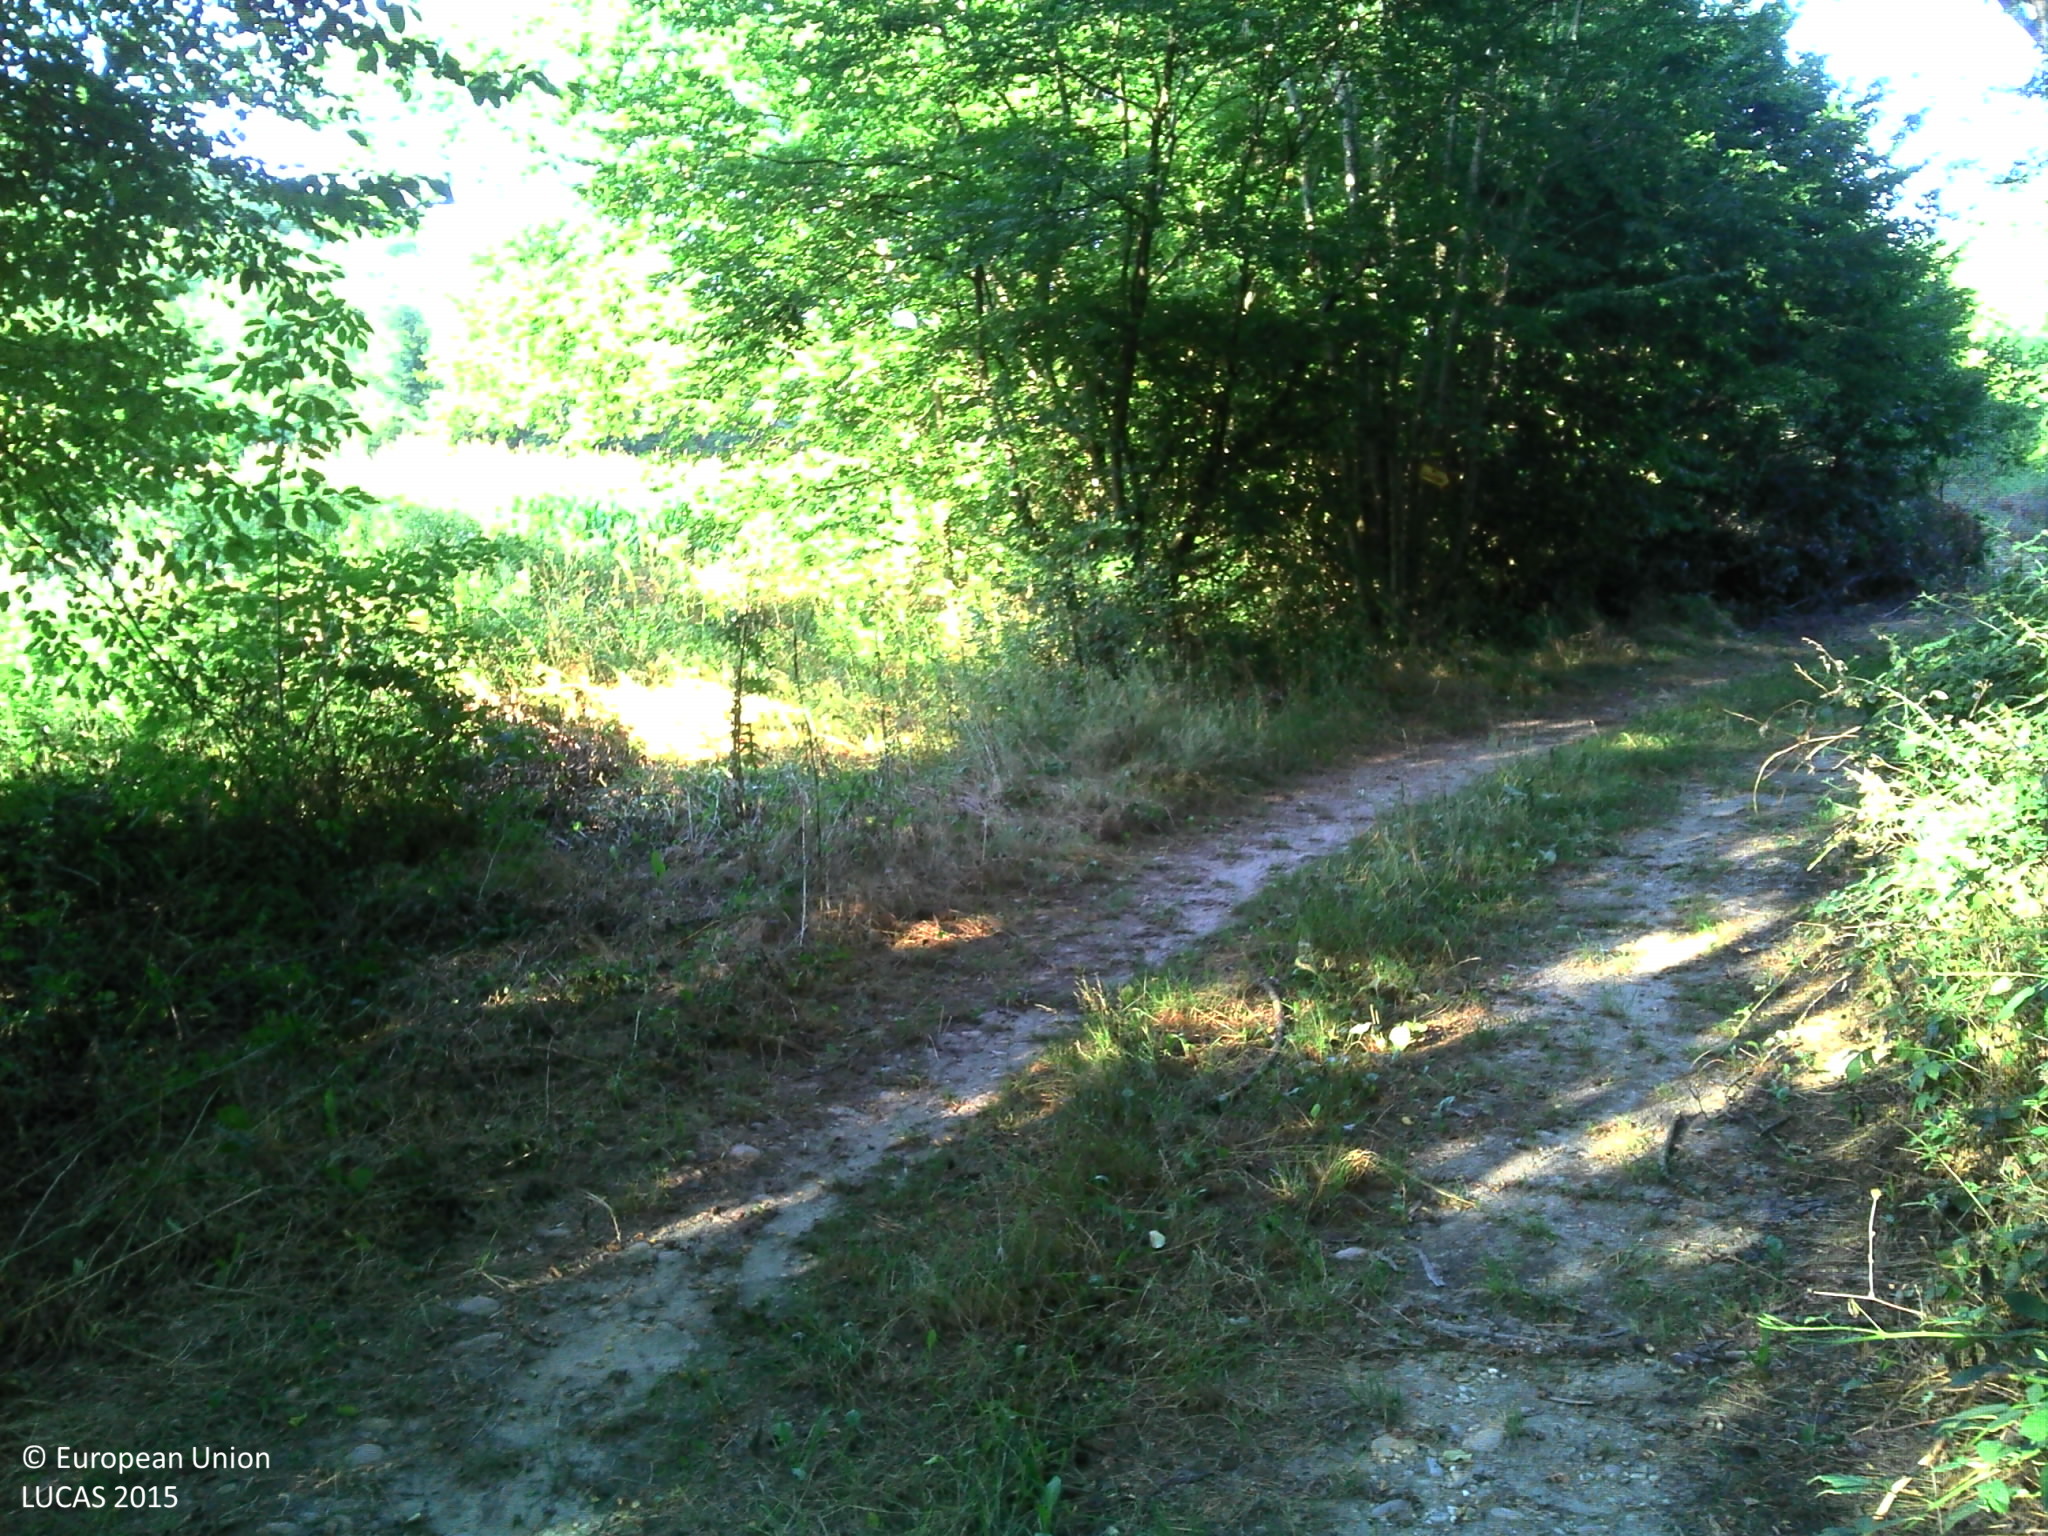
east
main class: Woodland
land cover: Broadleaved woodland
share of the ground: > 75 %
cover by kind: broadleaved forest trees 90 %, shrubs 5 %, herbaceous plants 5 %
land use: Forestry
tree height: > 5 m
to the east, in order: Broadleaved woodland; Rocks and stones; Rivers and streams; Spontaneously vegetated surfaces; Broadleaved woodland
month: July
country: FR
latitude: 45.4788
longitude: 5.0536
